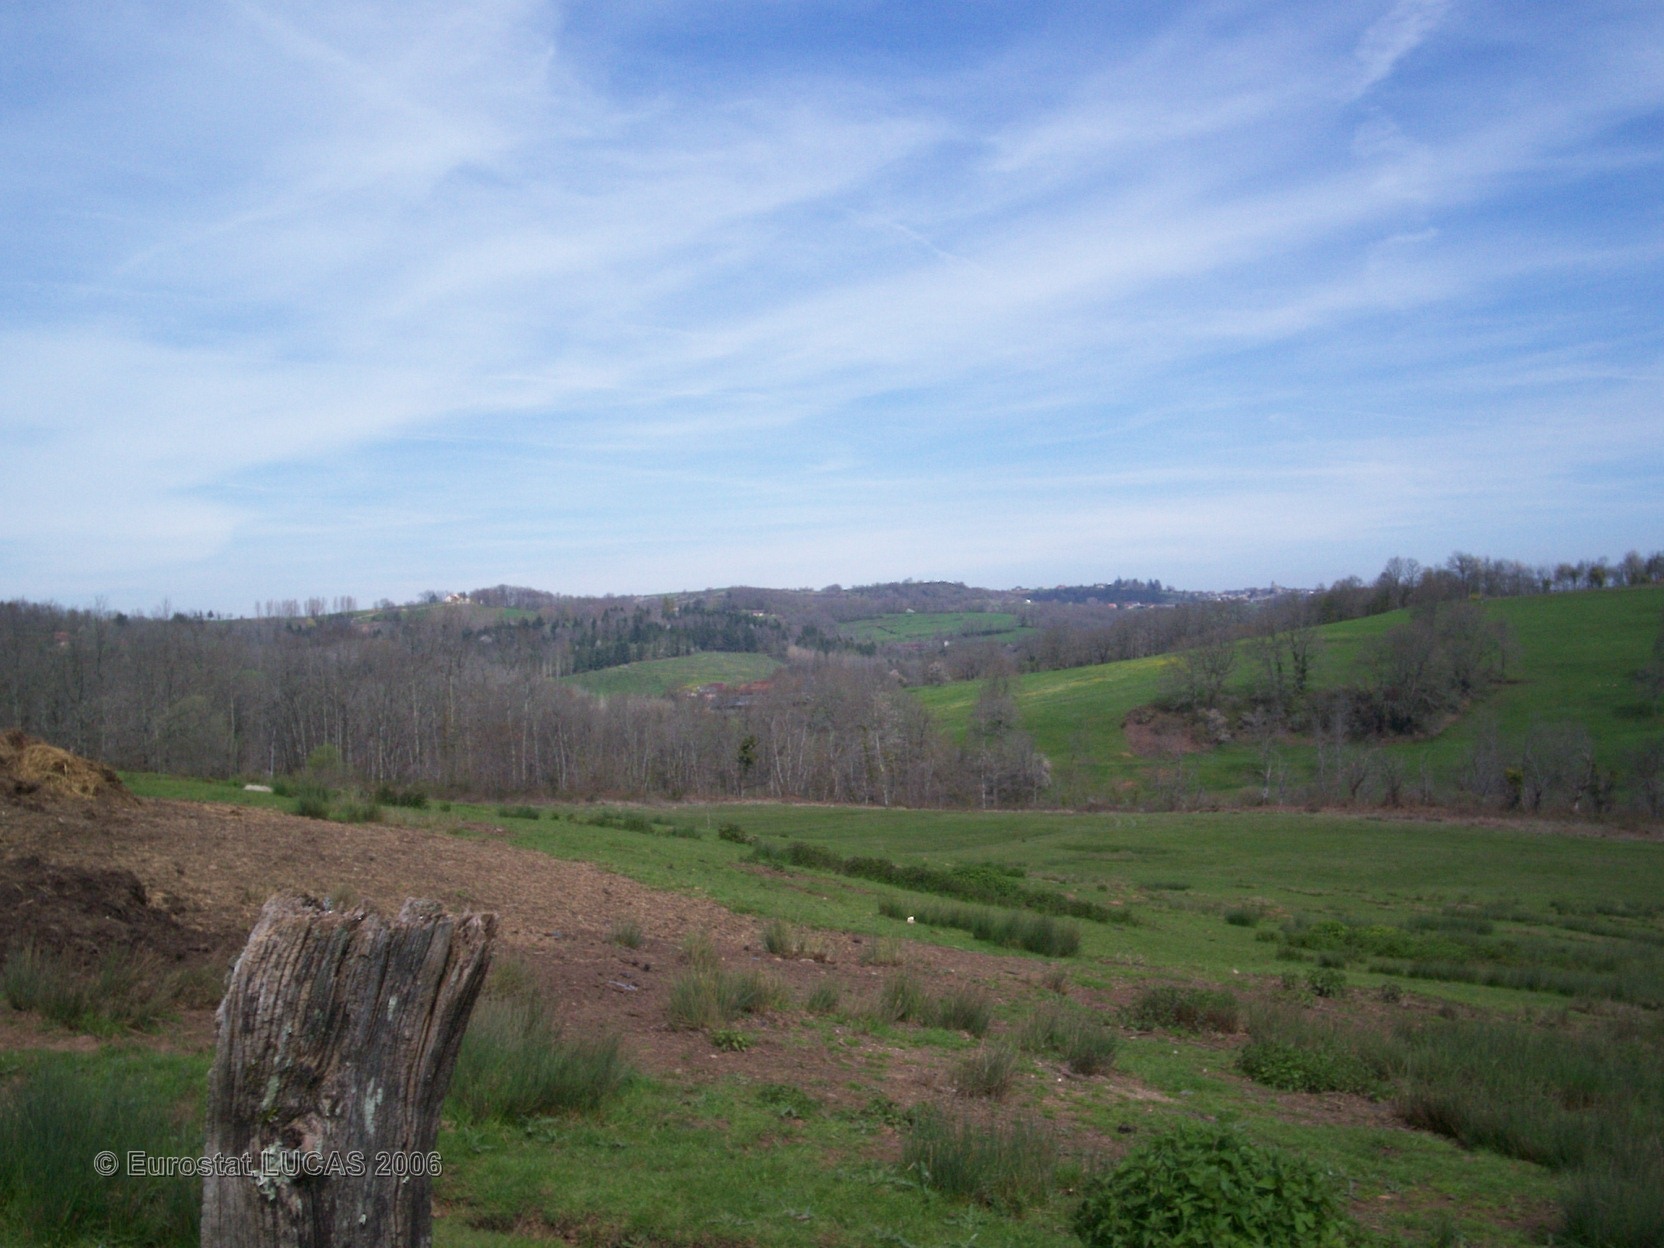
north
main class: Grassland
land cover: Grassland without tree/shrub cover
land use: Agriculture (excluding fallow land and kitchen gardens)
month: April
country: FR
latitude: 45.2169
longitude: 1.2964
